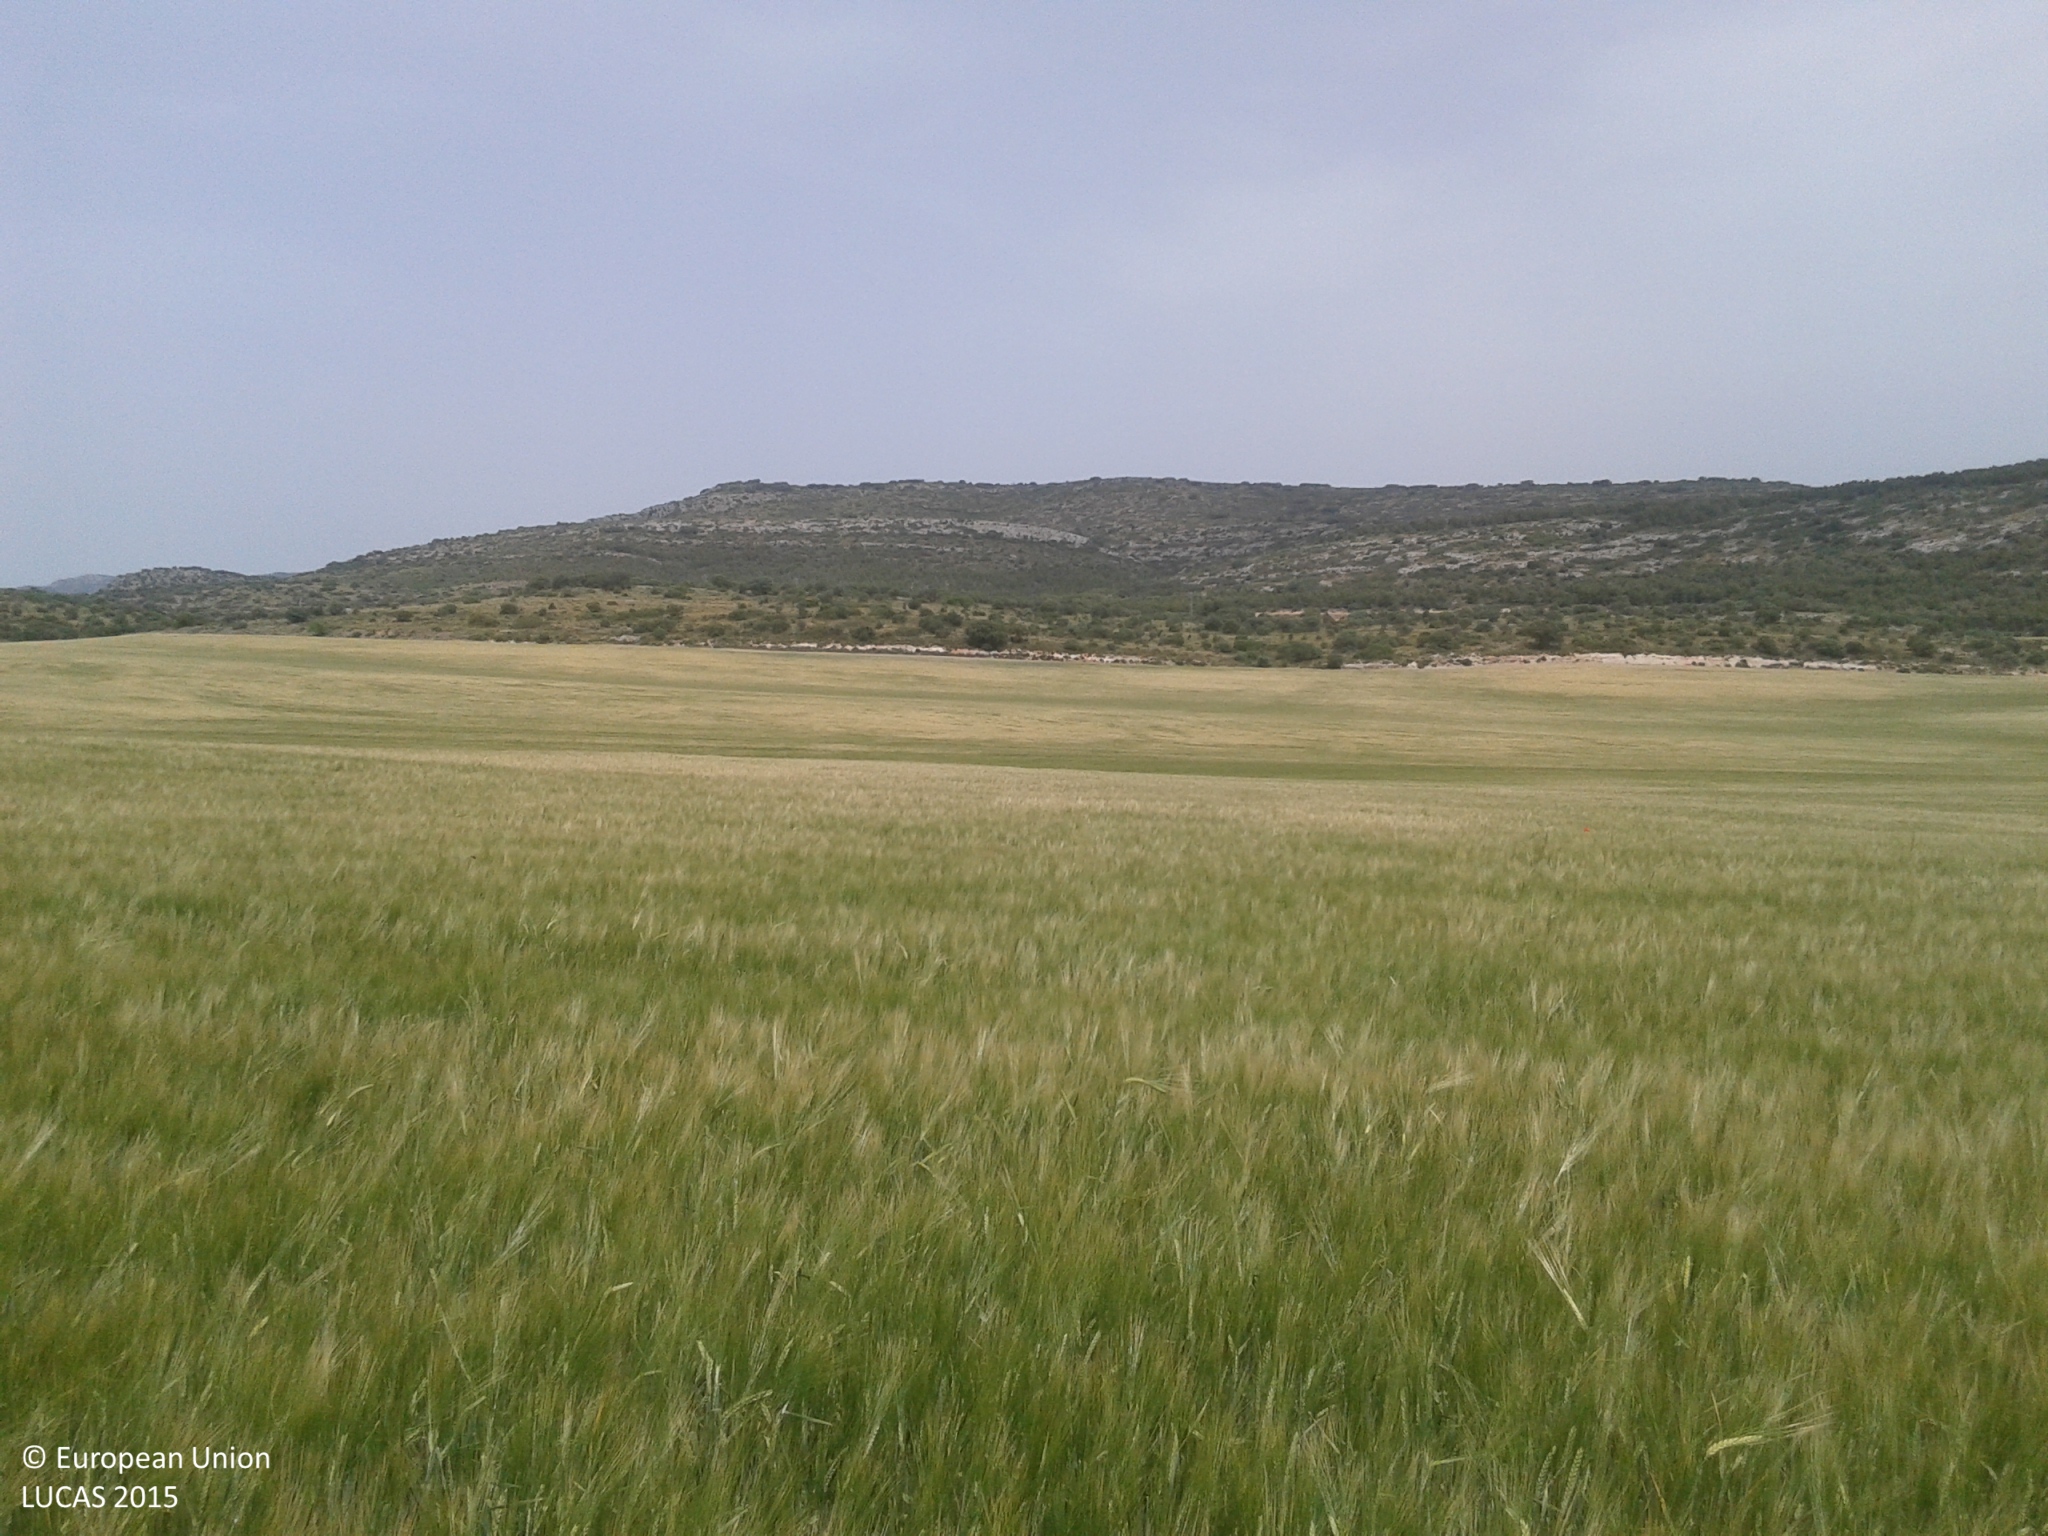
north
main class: Cropland
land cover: Barley
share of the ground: > 75 %
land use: Agriculture (excluding fallow land and kitchen gardens)
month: May
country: ES
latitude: 41.8237
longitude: 0.6797
